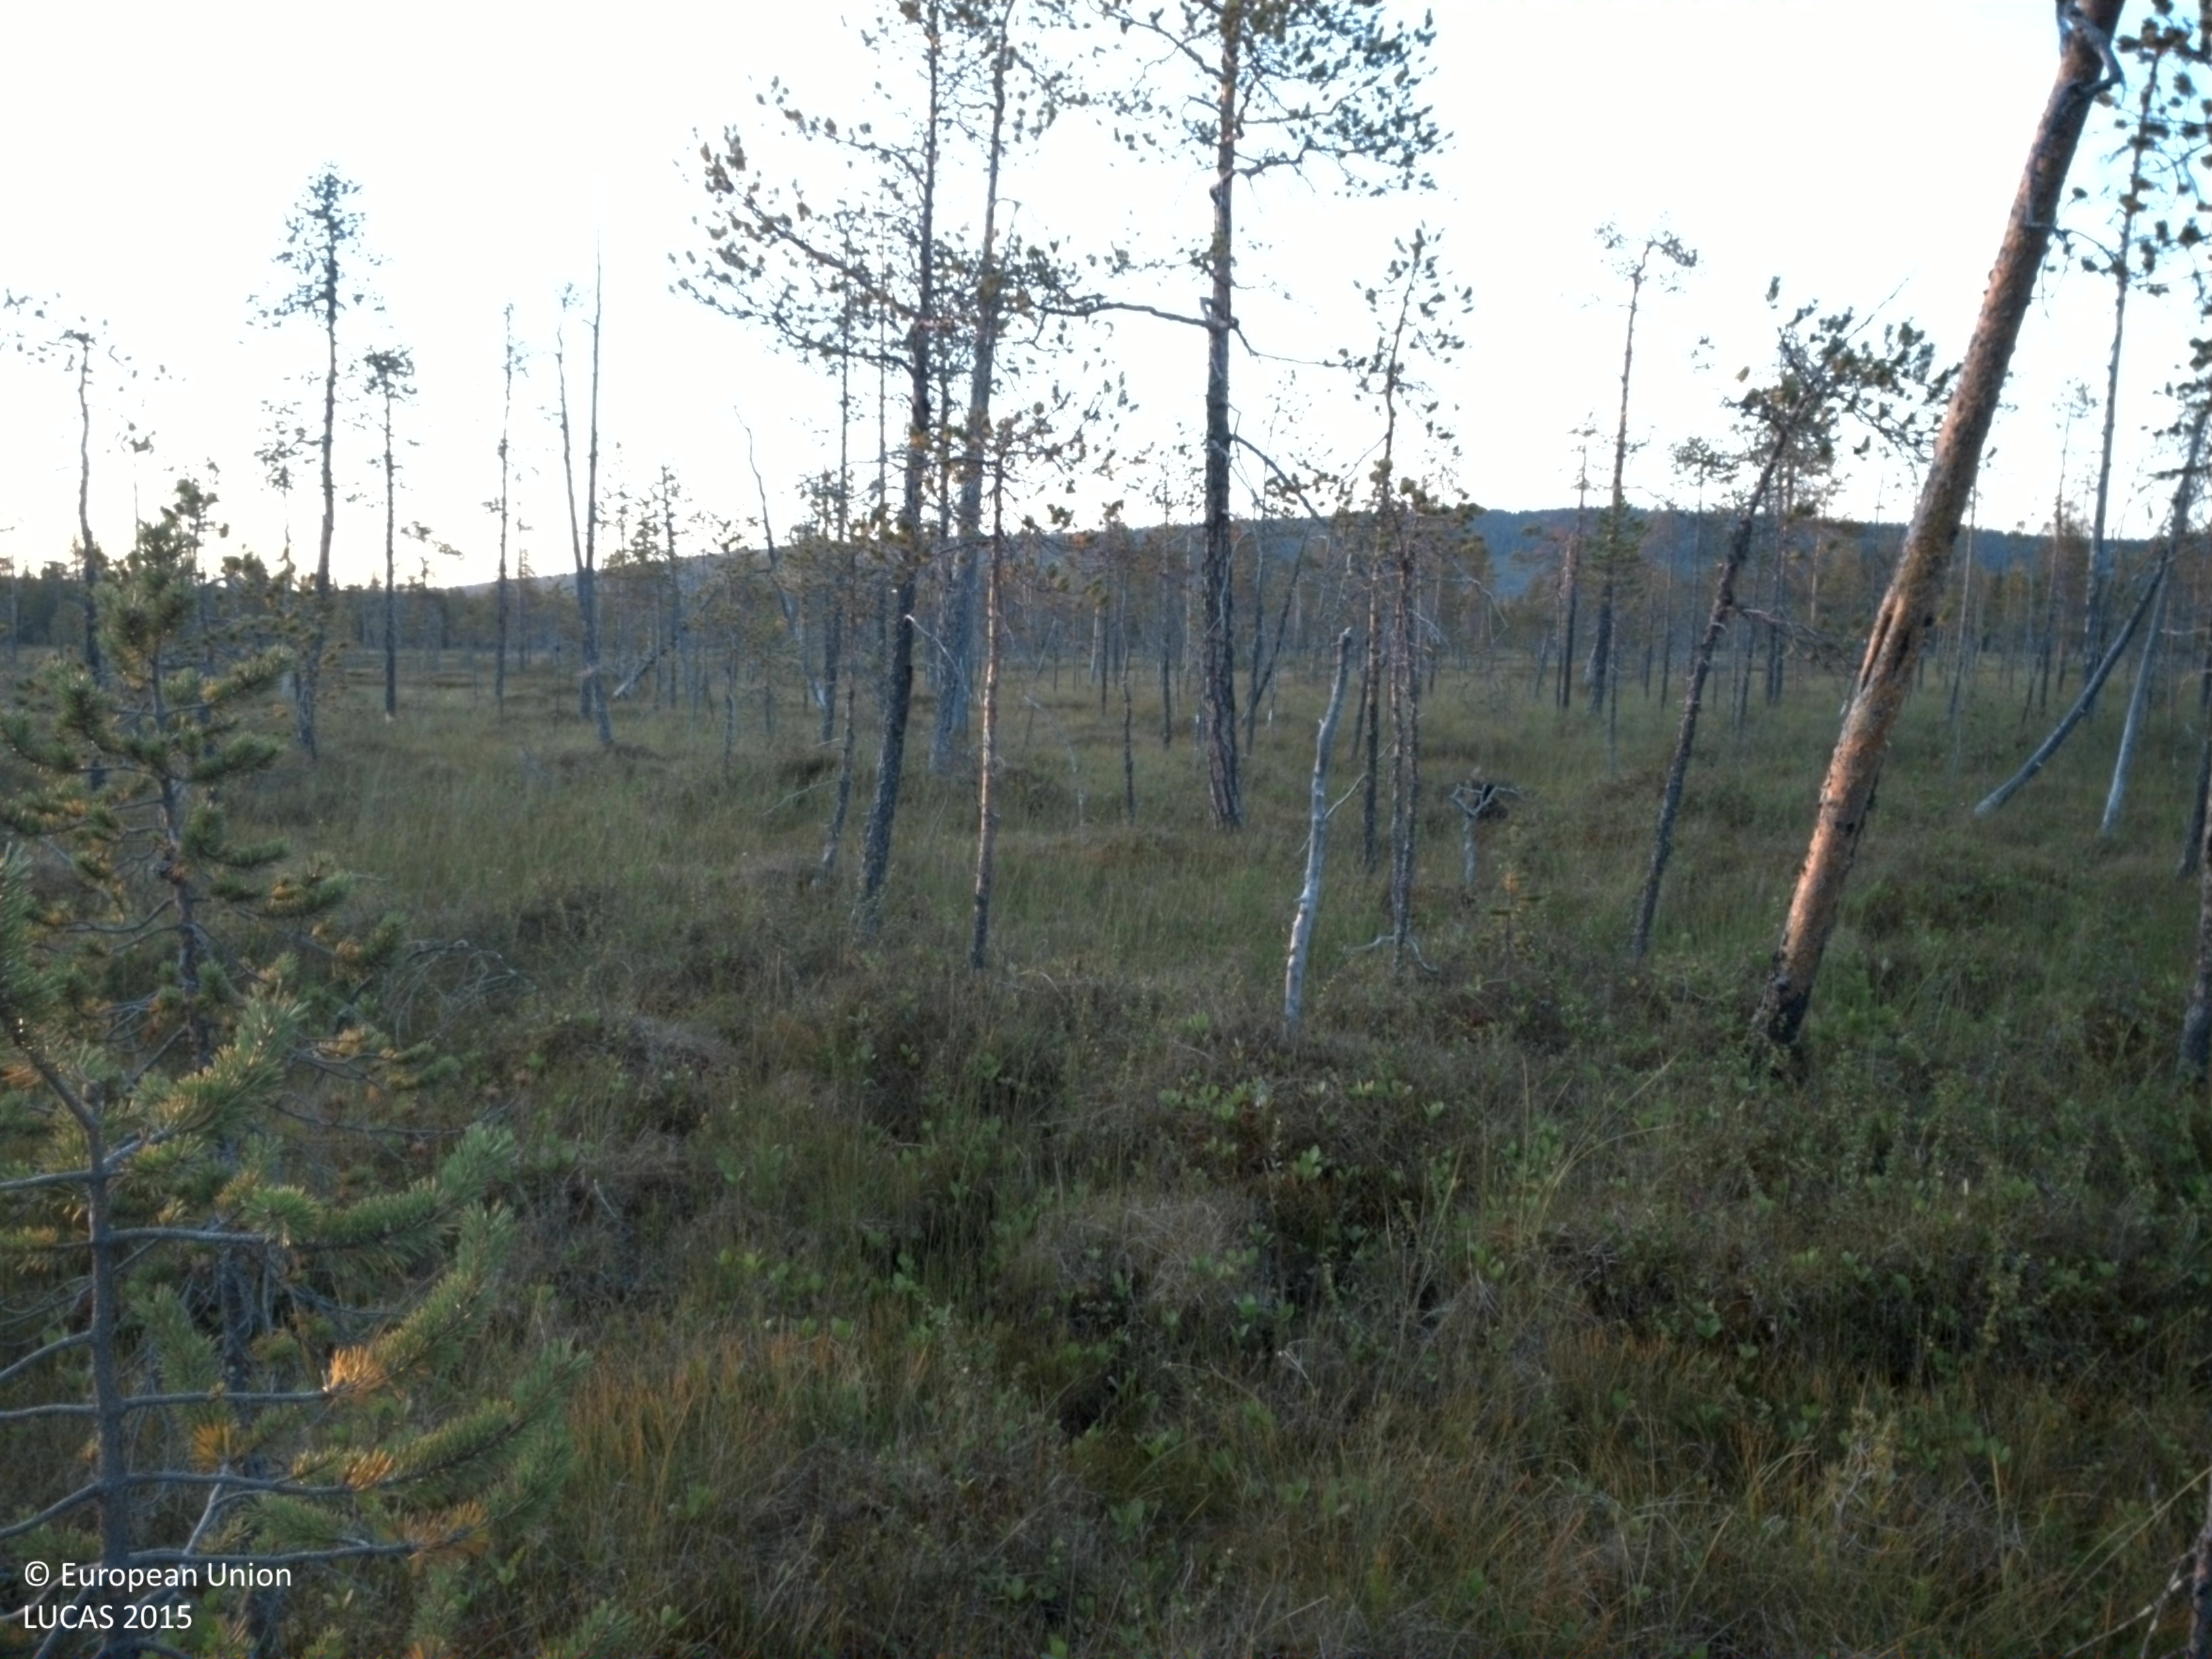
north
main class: Woodland
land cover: Pine dominated coniferous woodland
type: mire and swamp forests
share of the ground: 10 - 25 %
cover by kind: shrubs 55 %, coniferous forest trees 20 %, lichens and mosses 15 %, herbaceous plants 10 %
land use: Semi-natural and natural areas not in use
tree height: > 5 m
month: August
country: SE
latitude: 66.6124
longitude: 19.1389
